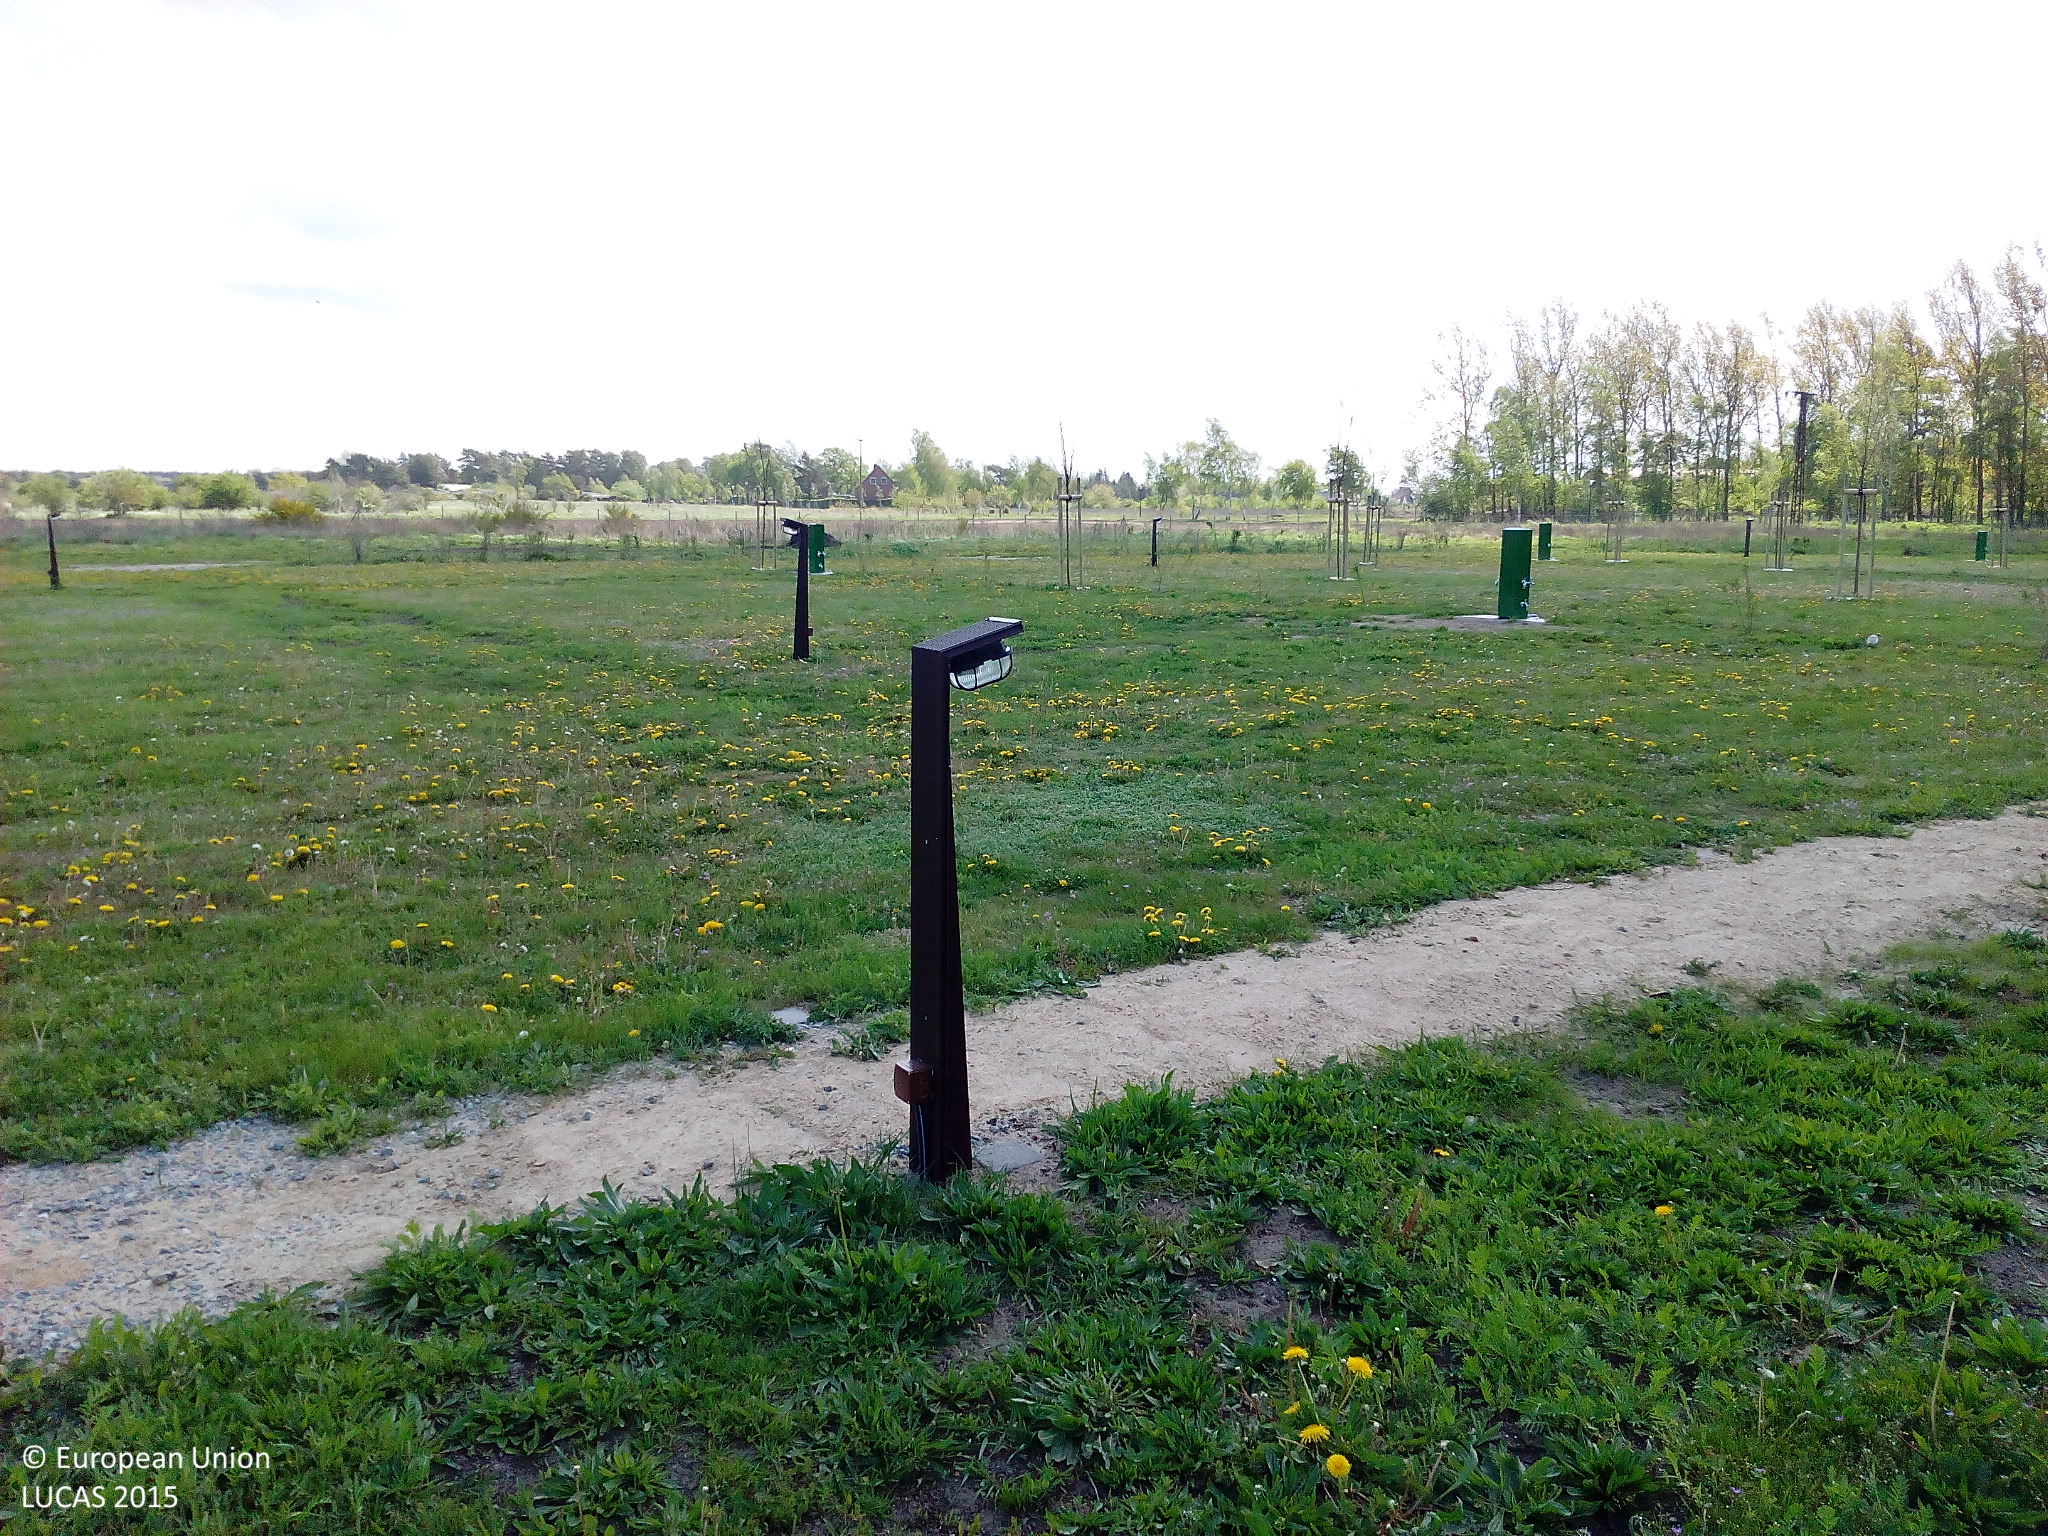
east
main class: Grassland
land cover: Grassland with sparse tree/shrub cover
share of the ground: > 75 %
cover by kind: herbaceous plants 85 %, broadleaved forest trees 5 %, shrubs 5 %, unconsolidated bare surface 5 %
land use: Amenities, museums, leisure
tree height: < 5 m
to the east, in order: Grassland with sparse tree/shrub cover; Tracks; Grassland without tree/shrub cover; Shruby margins; Fences; Grass margins; Maize; Grass margins; Grassland without tree/shrub cover; Grassland with sparse tree/shrub cover
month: May
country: DE
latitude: 54.3797
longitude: 12.6625
